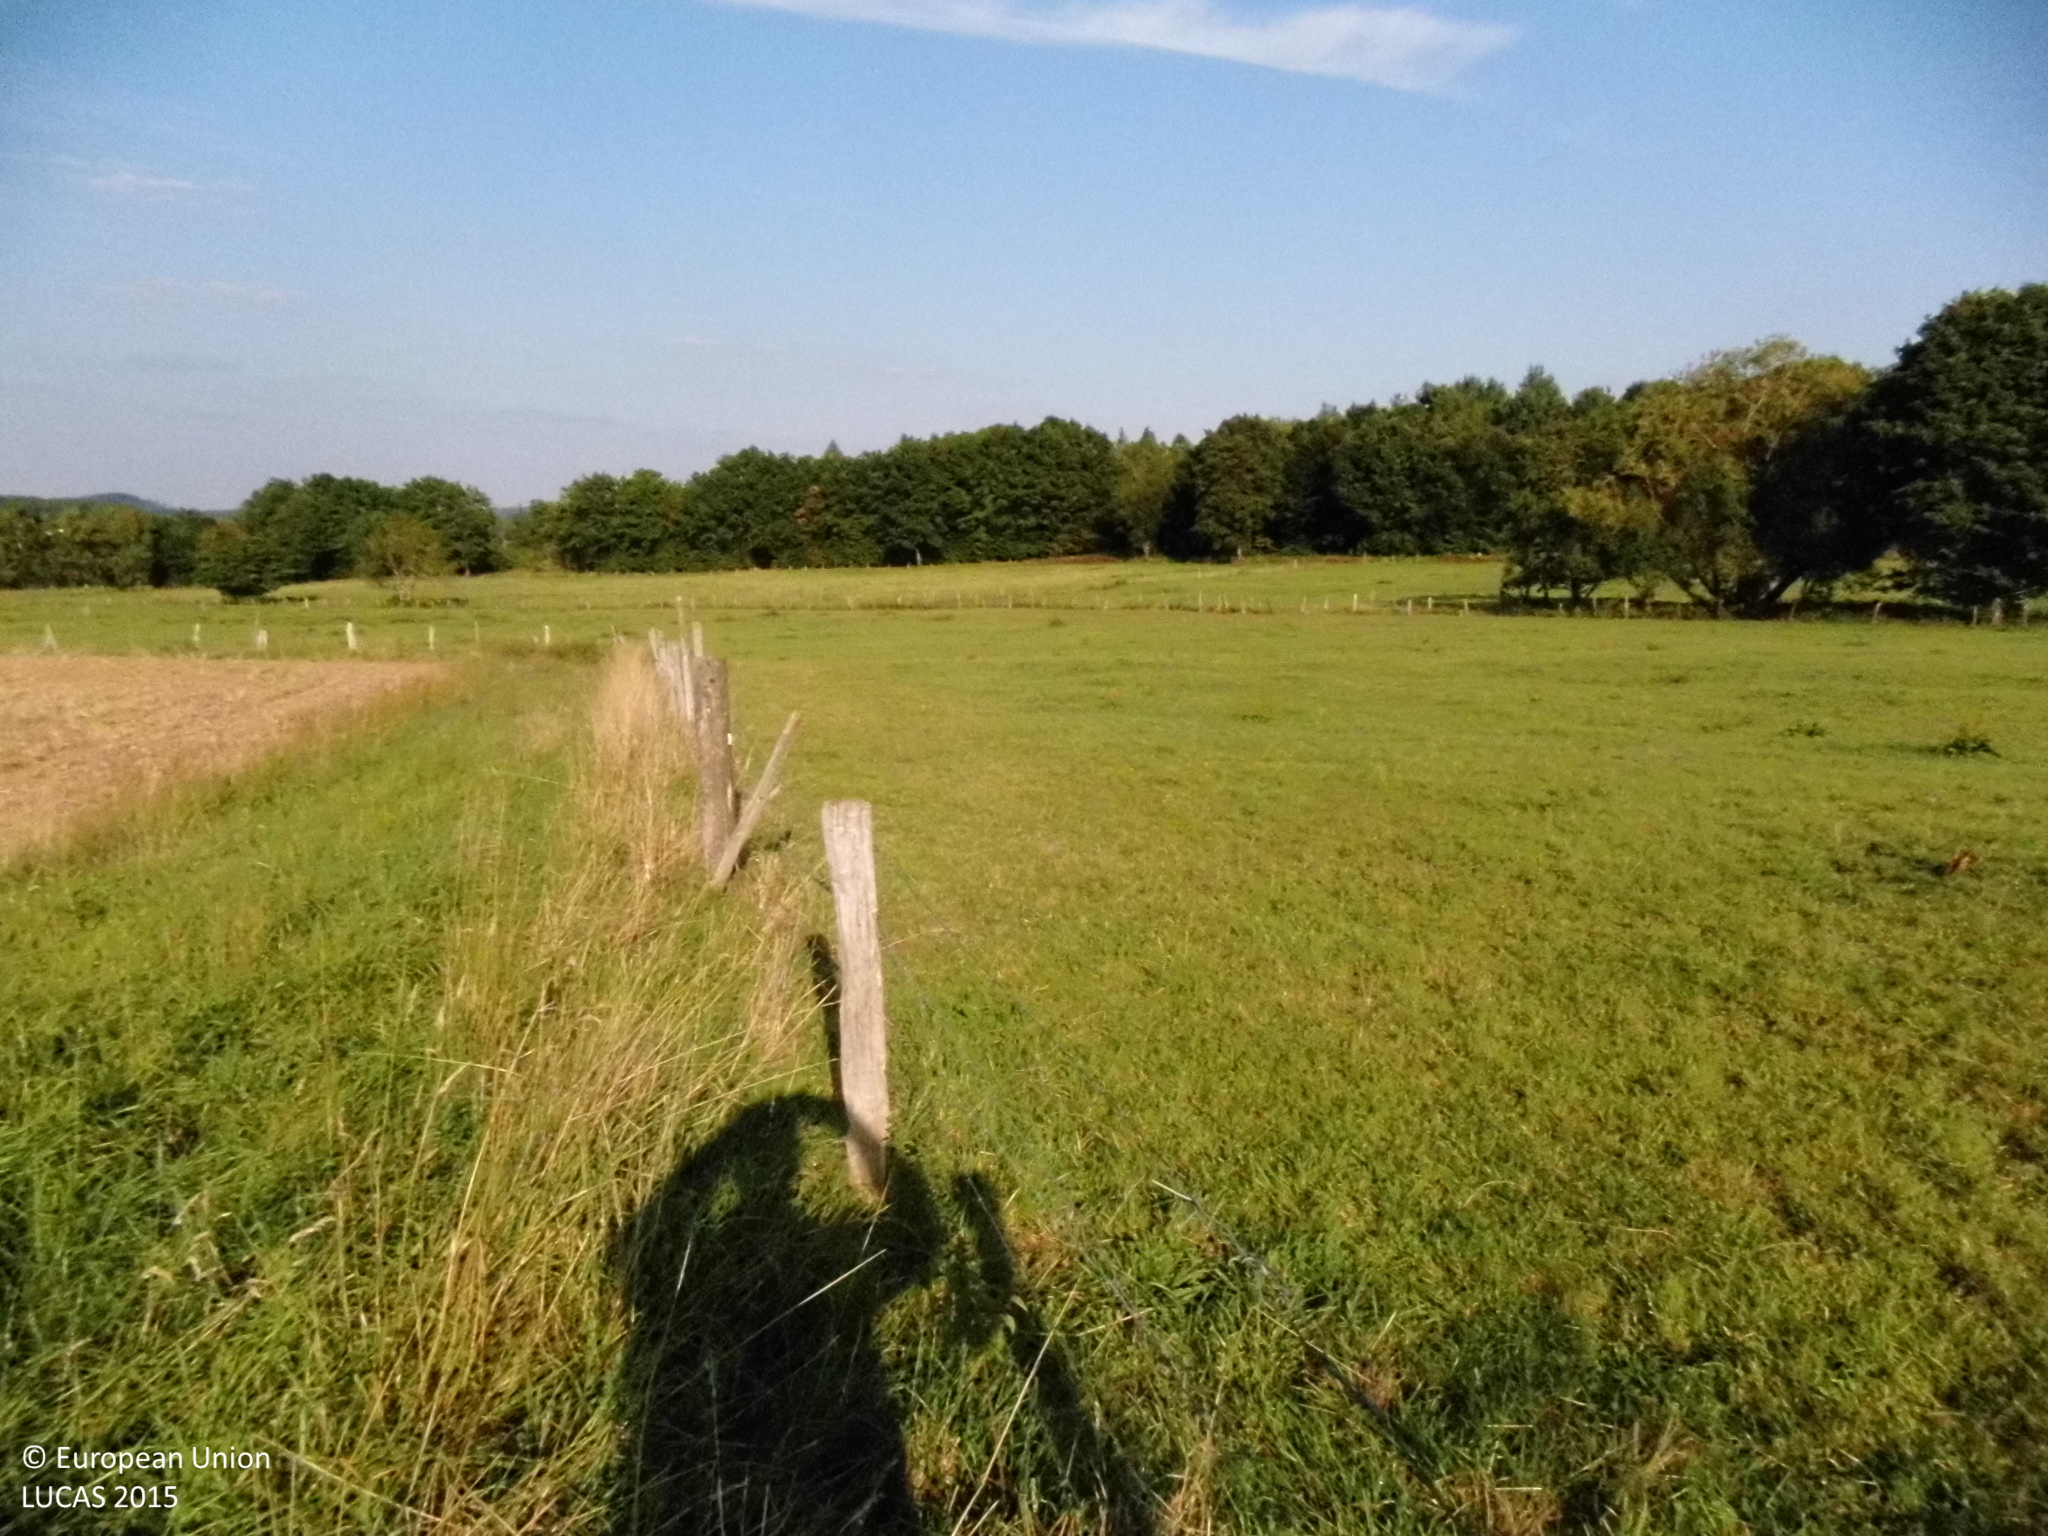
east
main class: Grassland
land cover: Grassland without tree/shrub cover
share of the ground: > 75 %
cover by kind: herbaceous plants 100 %
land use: Agriculture (excluding fallow land and kitchen gardens)
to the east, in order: Grassland without tree/shrub cover; Fences; Ditches and canals; Fences; Grassland without tree/shrub cover; Fences; Grassland without tree/shrub cover; Fences; Ditches and canals; Grass margins; Tracks; Grass margins; Broadleaved woodland; Grassland with sparse tree/shrub cover
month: August
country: DE
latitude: 50.4921
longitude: 8.0974
